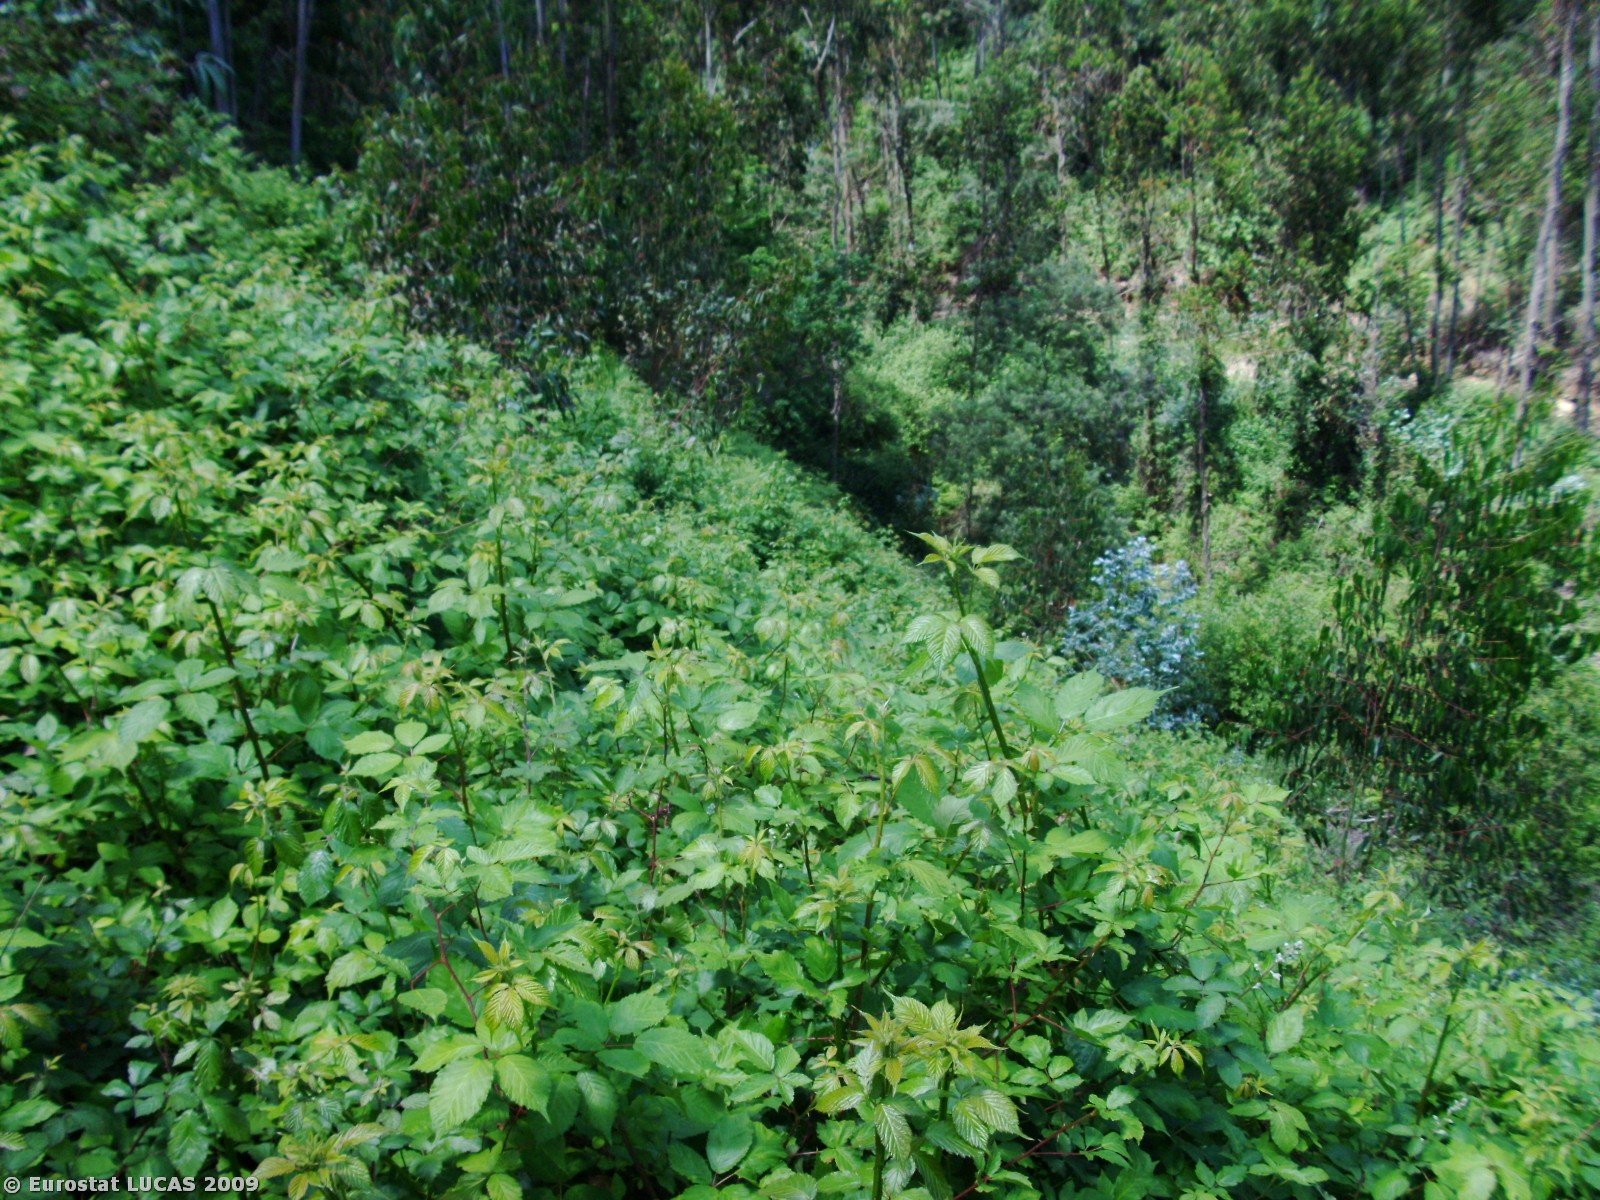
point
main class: Shrubland
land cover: Shrubland with sparse tree cover
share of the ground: > 75 %
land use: Forestry
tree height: > 5 m
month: May
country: PT
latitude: 40.2946
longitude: -8.3524
